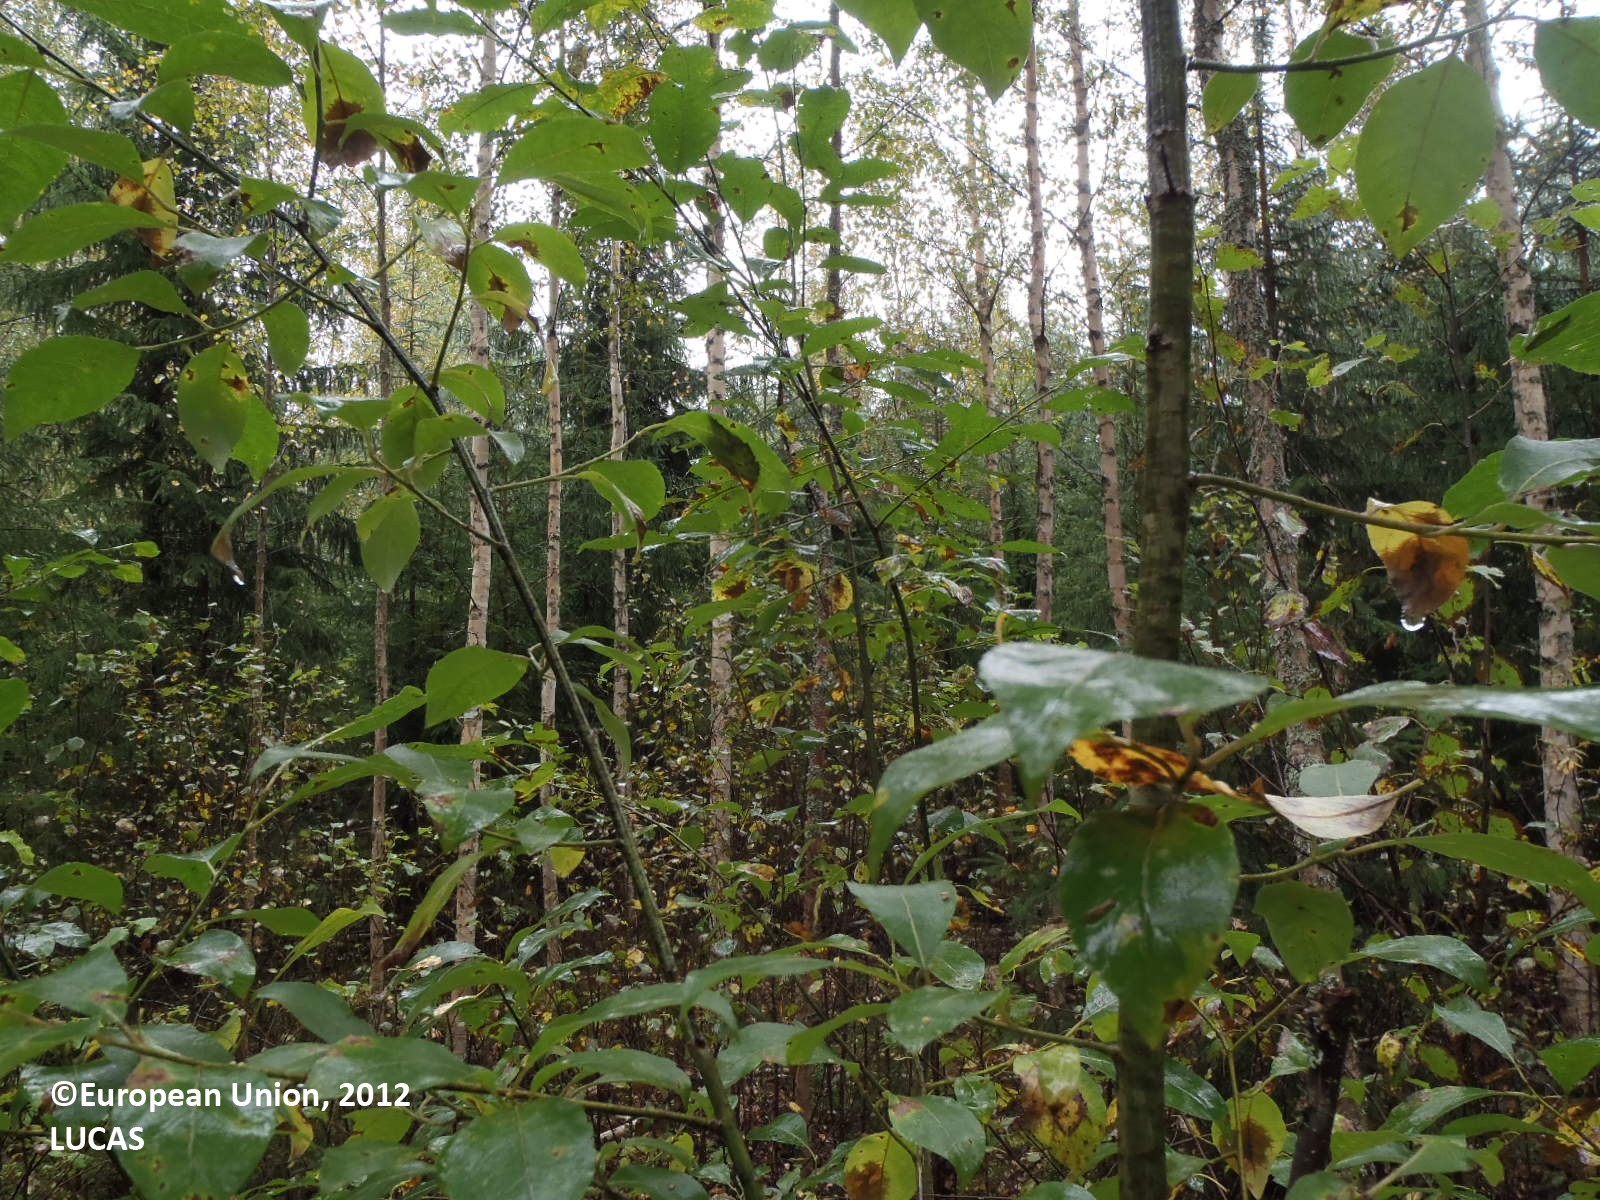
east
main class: Woodland
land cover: Broadleaved woodland
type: boreal forest
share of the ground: > 75 %
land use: Forestry
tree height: > 5 m
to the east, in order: Broadleaved woodland; Ditches and canals; Pine dominated coniferous woodland; Ditches and canals; Pine dominated coniferous woodland; Ditches and canals; Pine dominated coniferous woodland; Rock outcrops; Ditches and canals; Grass margins; Paved roads, cycling and walking lanes; Grass margins; Ditches and canals; Pine dominated coniferous woodland
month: September
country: FI
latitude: 61.6049
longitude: 22.5995
